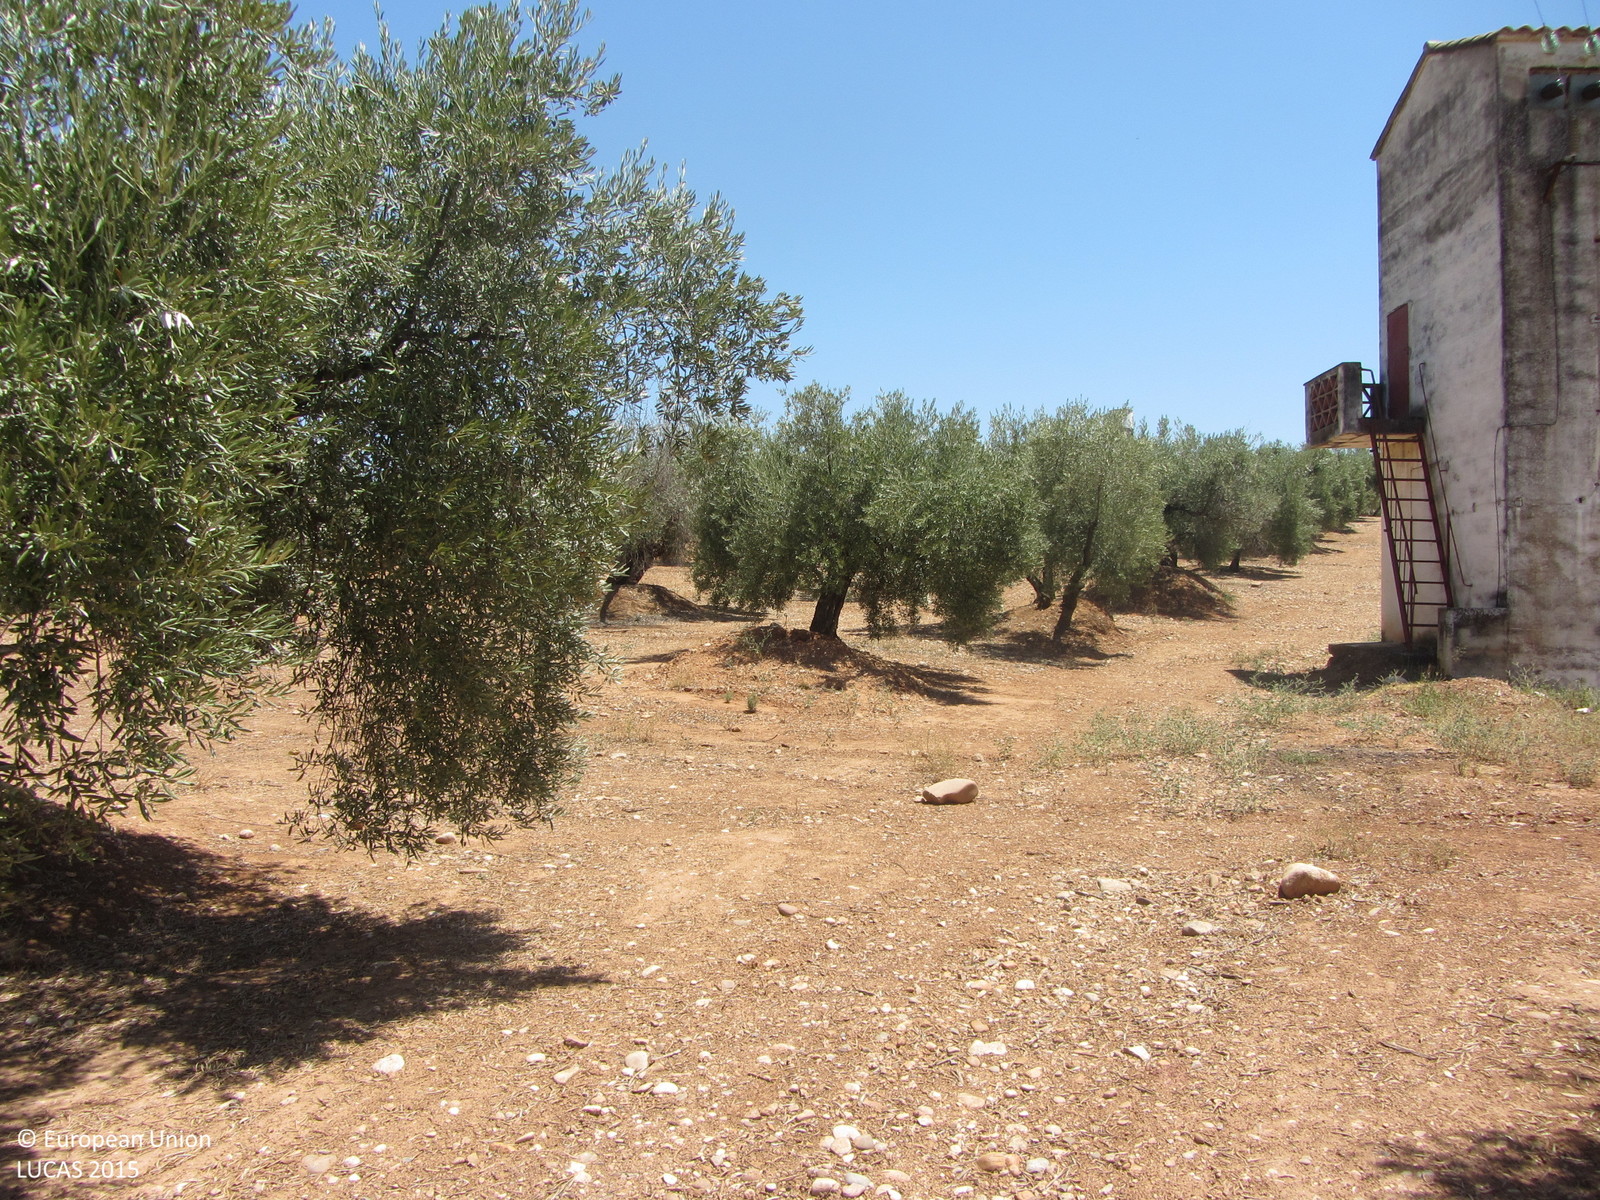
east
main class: Cropland
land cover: Olive groves
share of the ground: 25 - 50 %
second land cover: Other bare soil
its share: > 75 %
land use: Agriculture (excluding fallow land and kitchen gardens)
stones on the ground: 10 - 25 %
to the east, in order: Olive groves; Other bare soil
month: July
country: ES
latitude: 38.0441
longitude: -3.8963
